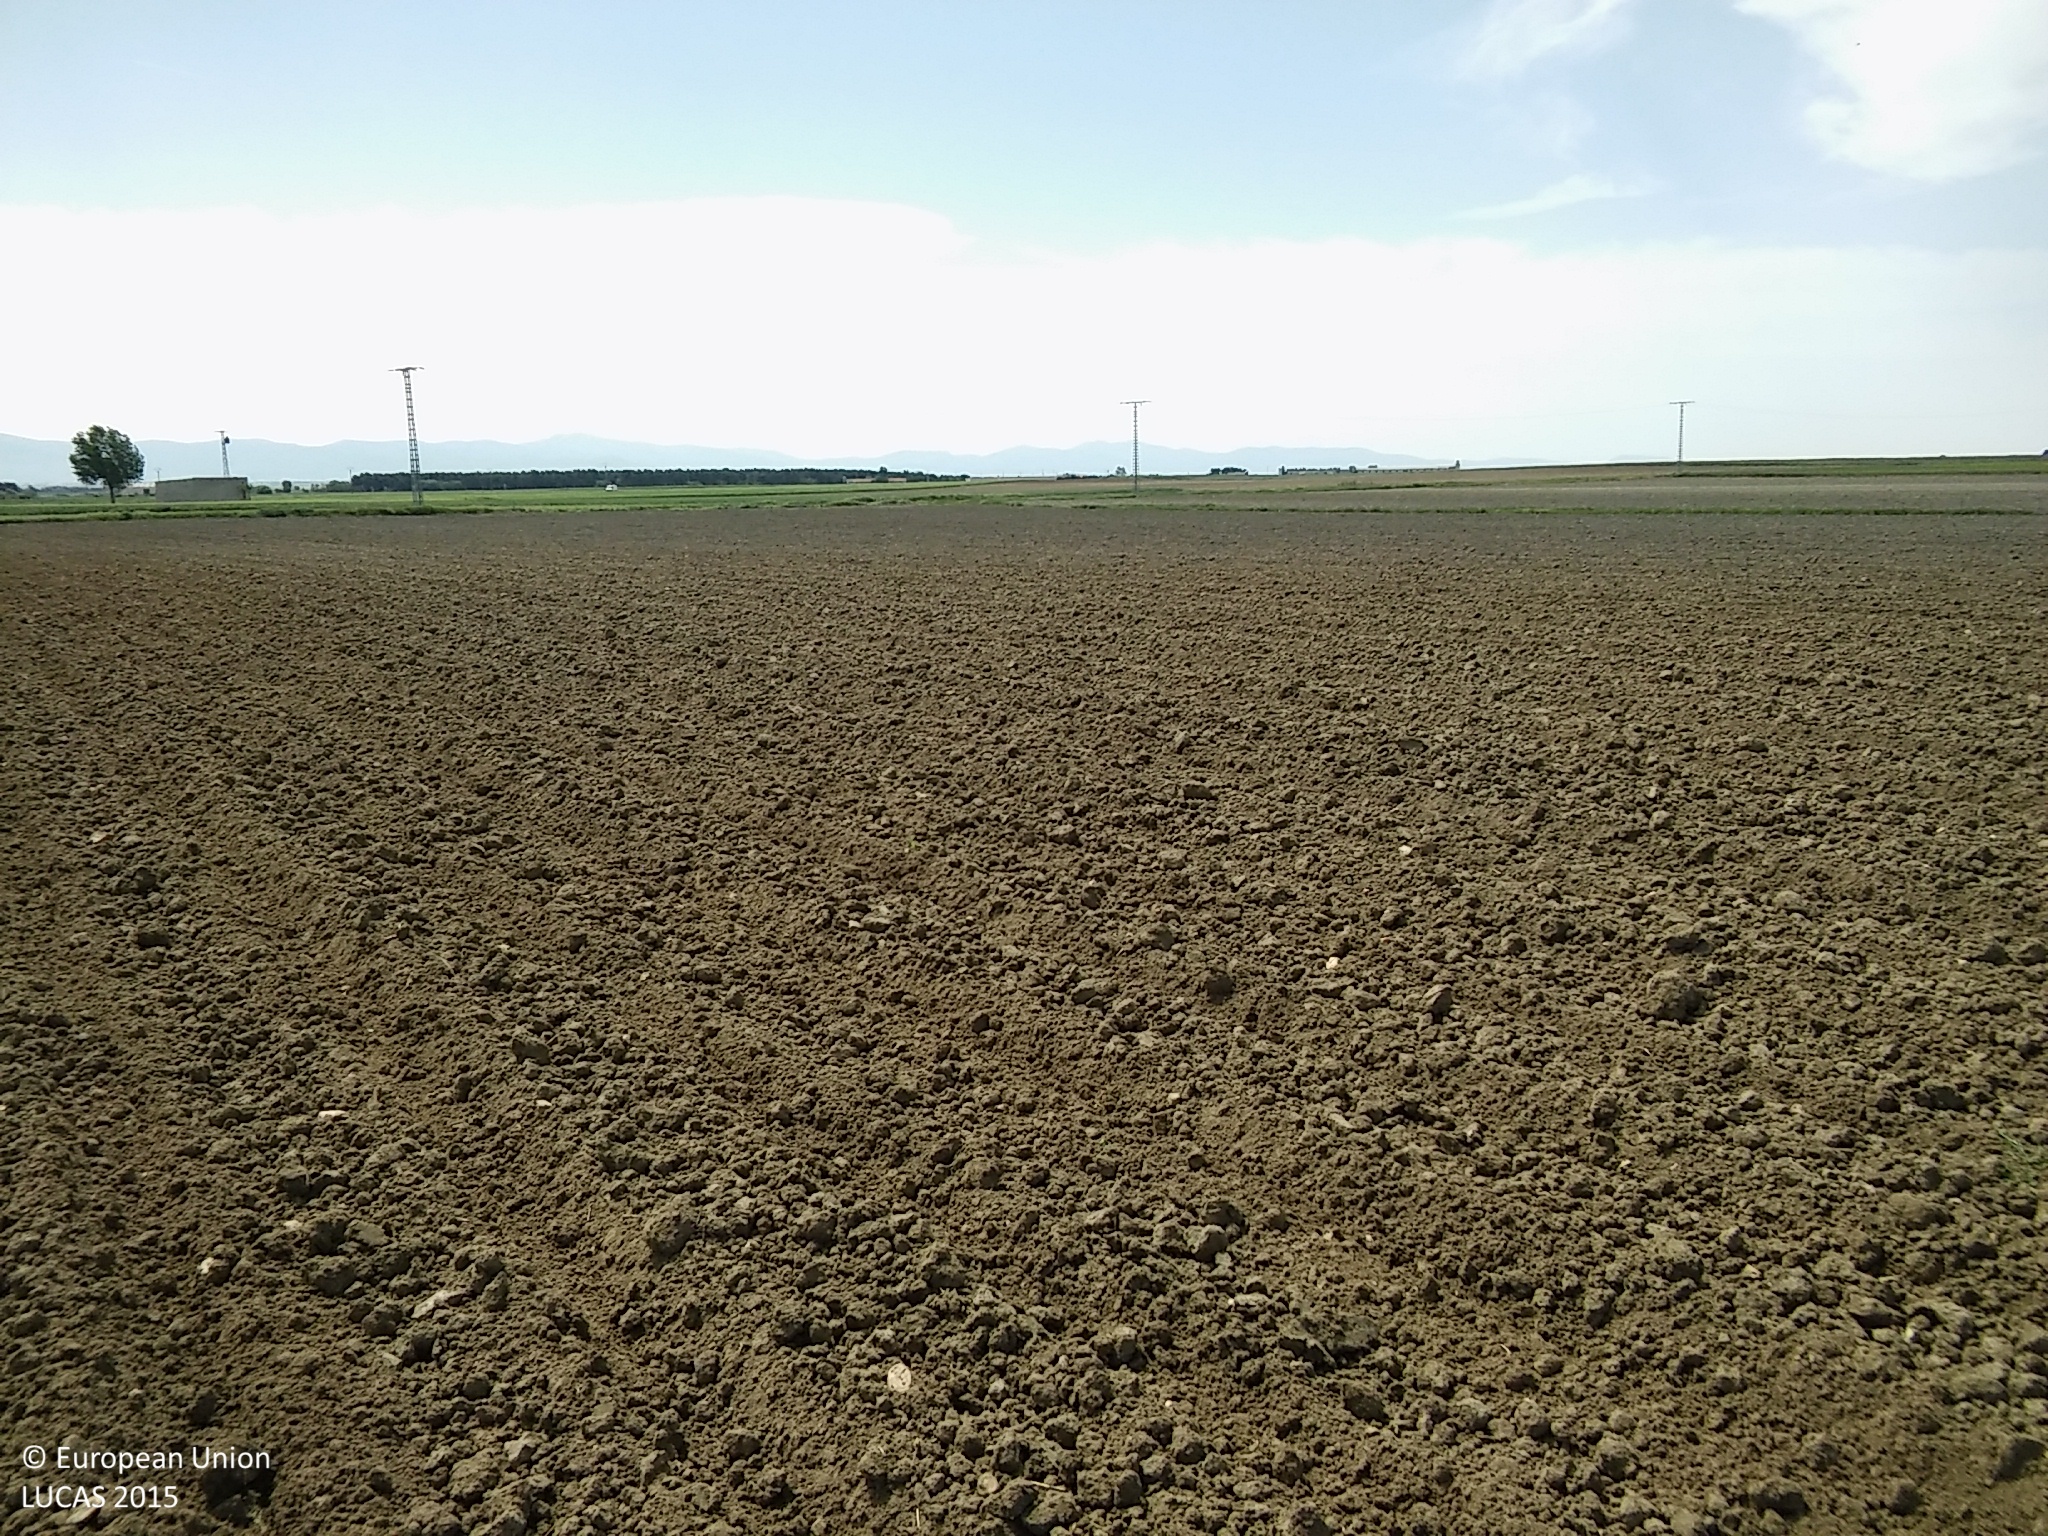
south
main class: Cropland
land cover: Sunflower
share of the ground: < 10 %
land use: Agriculture (excluding fallow land and kitchen gardens)
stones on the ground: < 10 %
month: May
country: ES
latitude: 41.2202
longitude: -4.1171
